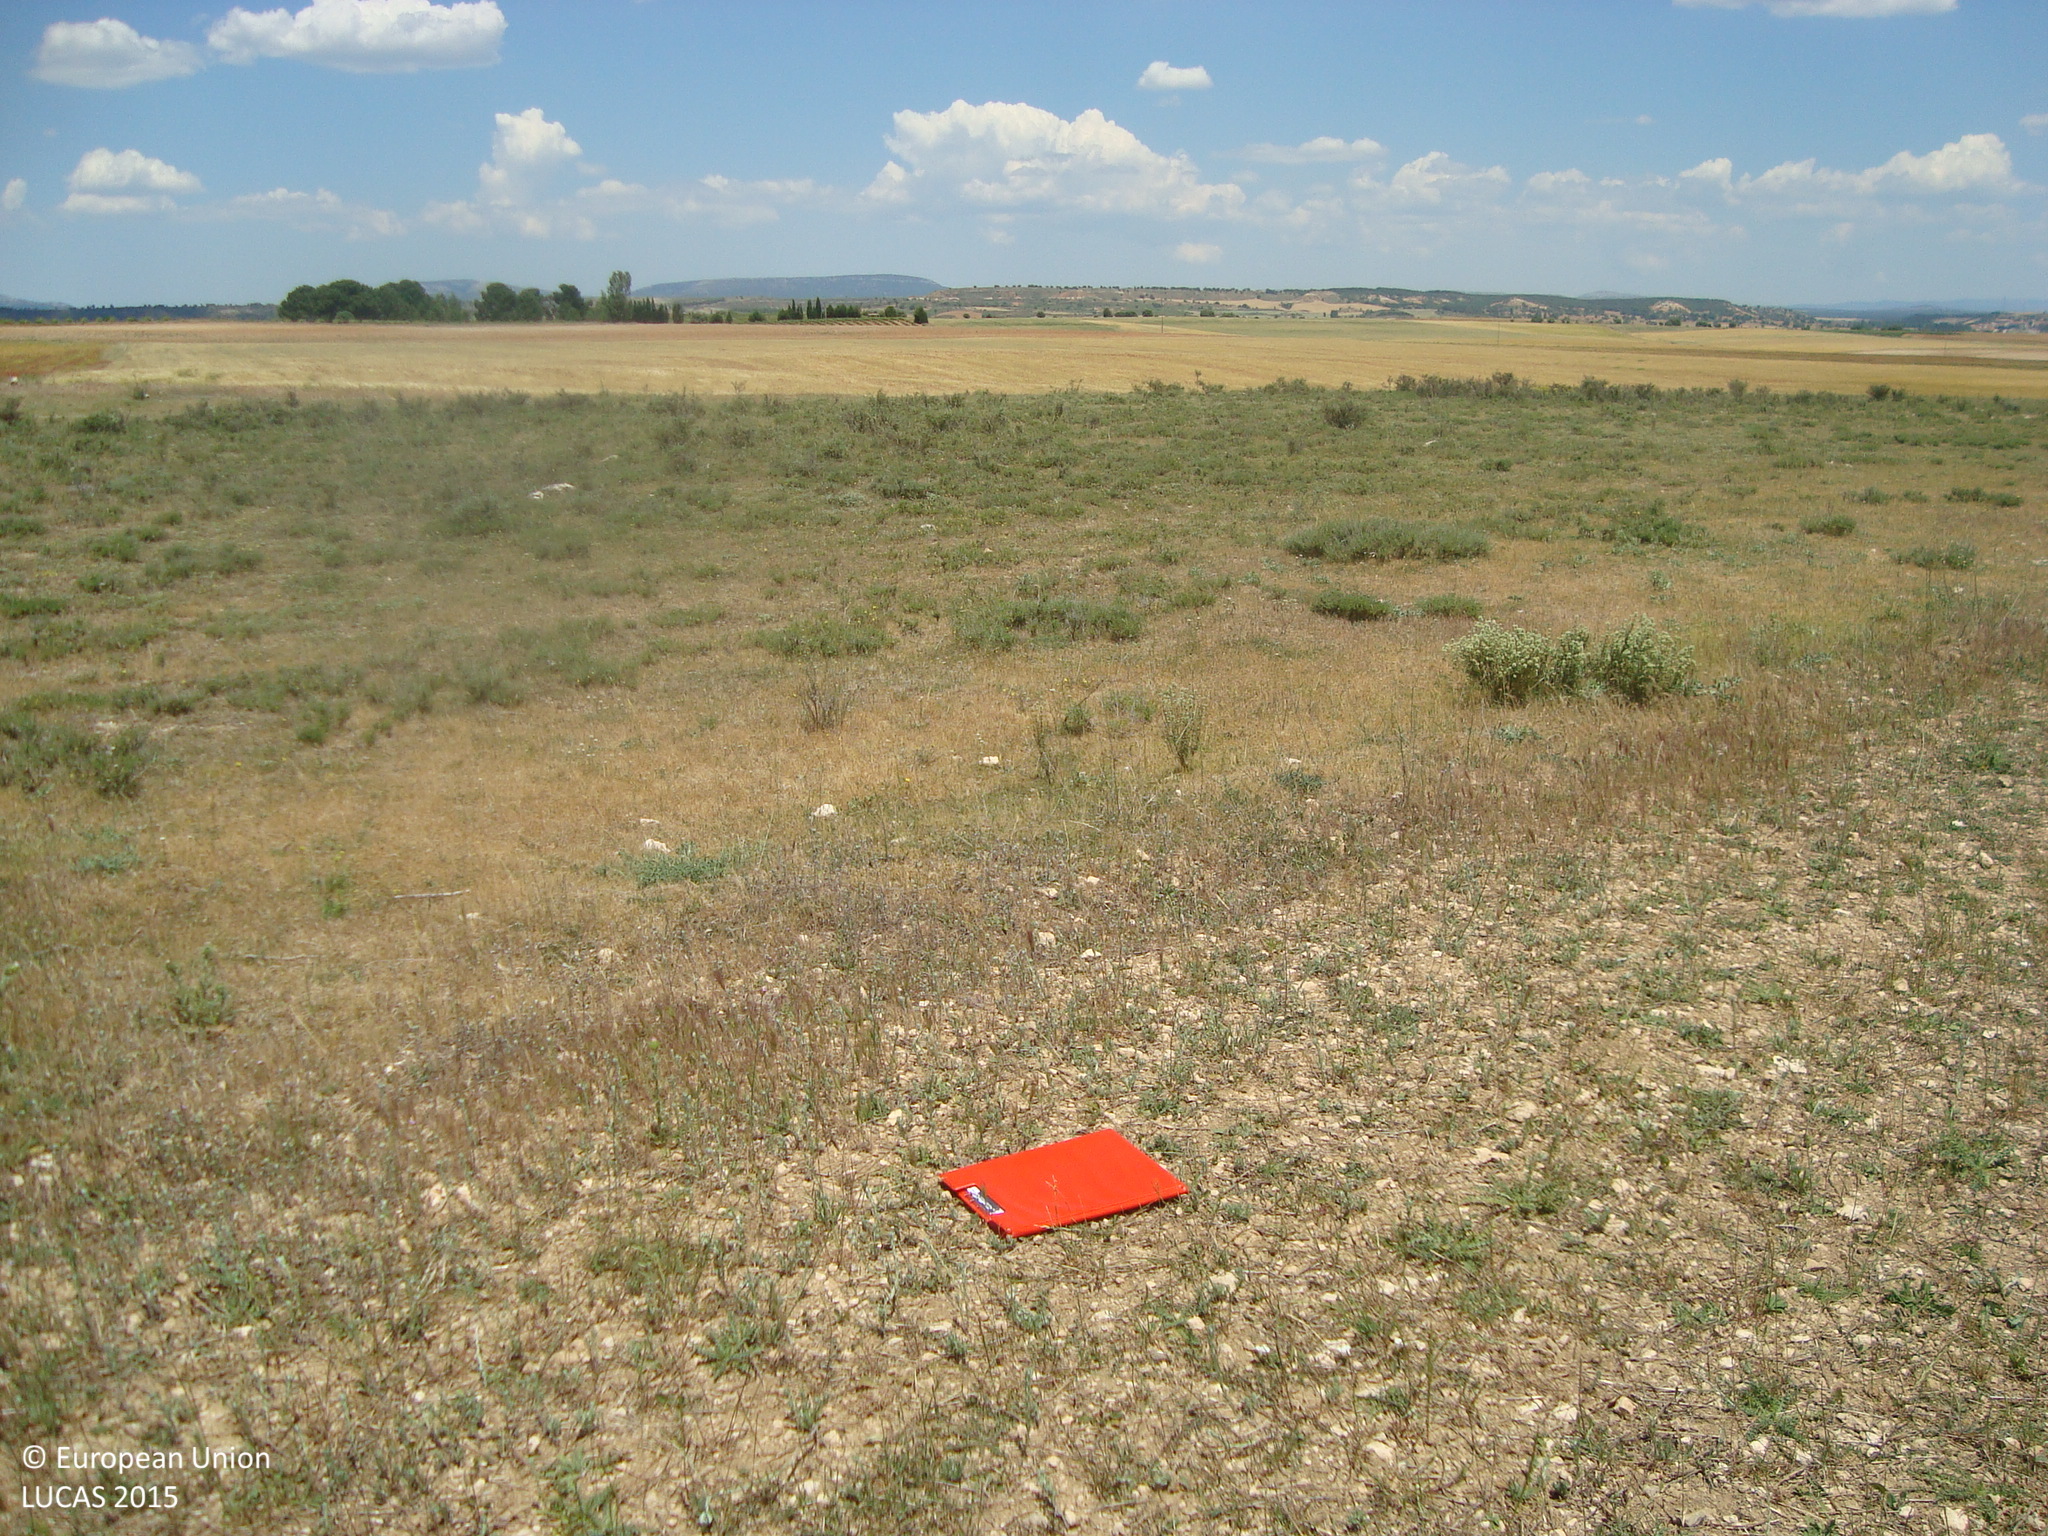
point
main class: Grassland
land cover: Spontaneously vegetated surfaces
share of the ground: 25 - 50 %
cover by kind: unconsolidated bare surface 75 %, herbaceous plants 25 %
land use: Agriculture (excluding fallow land and kitchen gardens)
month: June
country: ES
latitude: 41.7947
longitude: -3.5424
